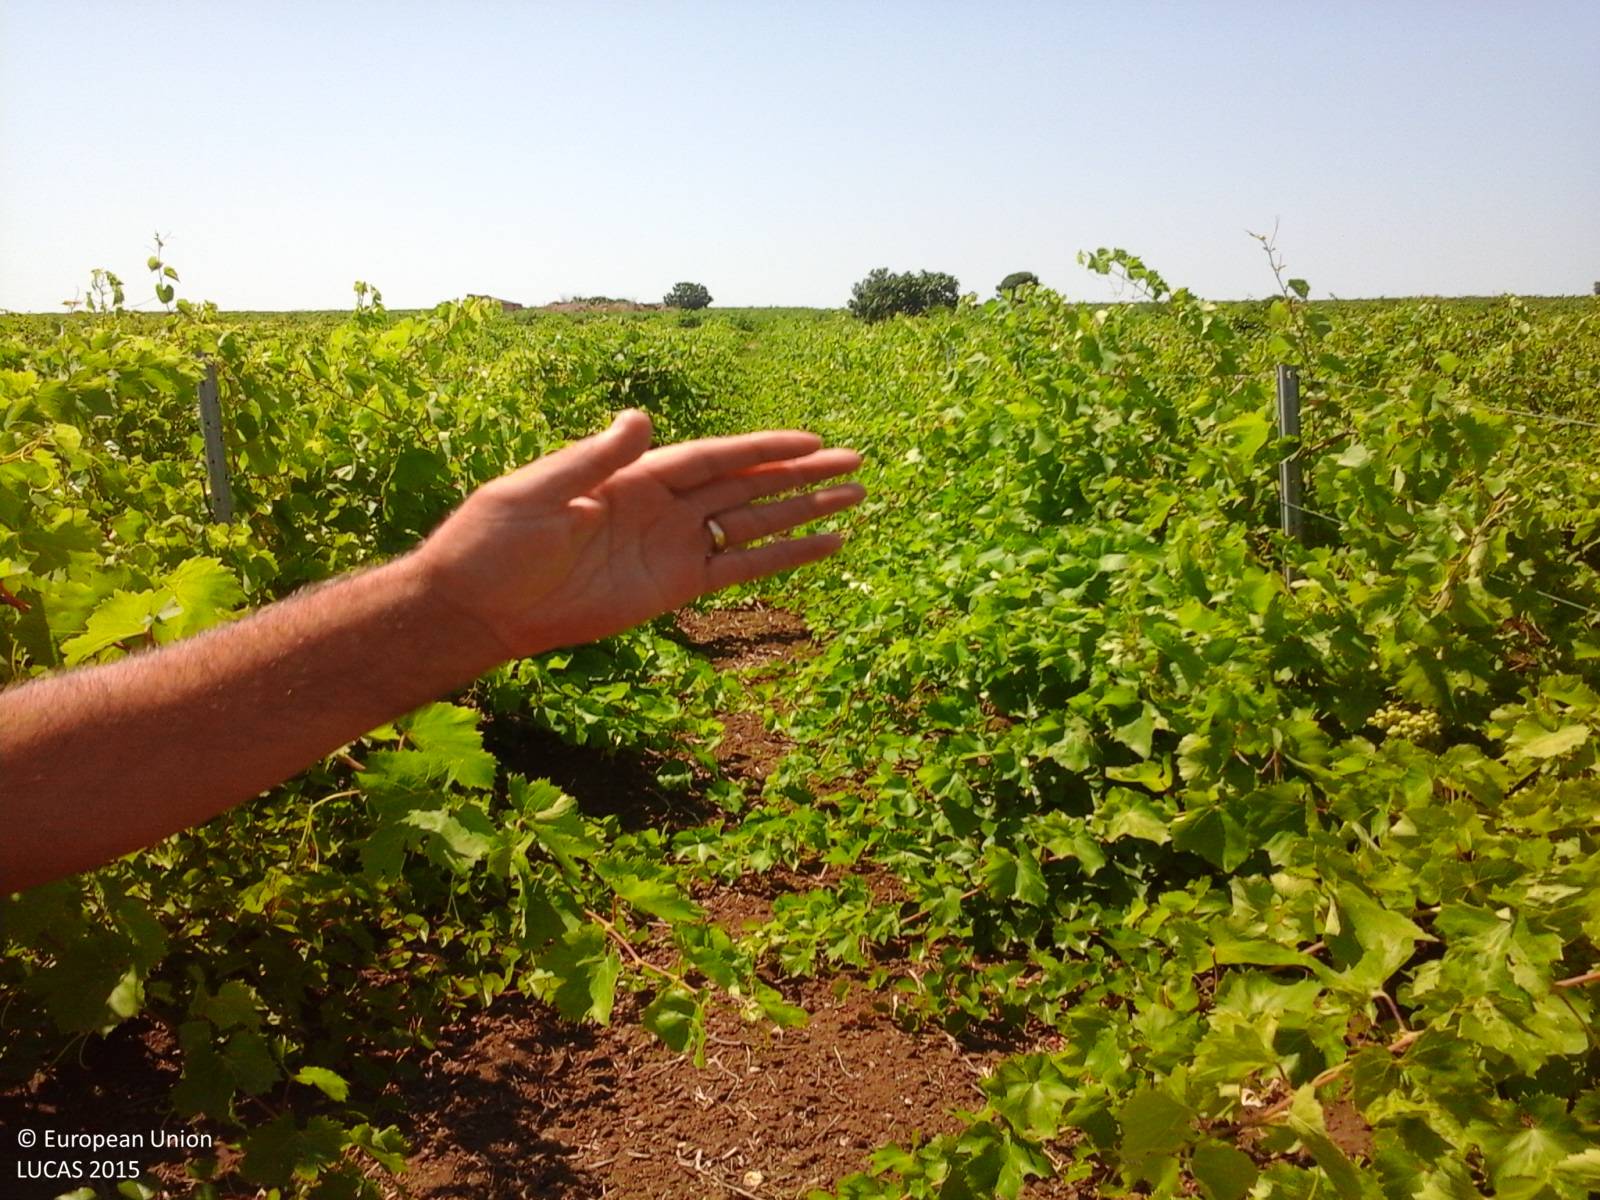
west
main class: Cropland
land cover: Vineyards
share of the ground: 50 - 75 %
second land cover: Other bare soil
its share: > 75 %
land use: Agriculture (excluding fallow land and kitchen gardens)
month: July
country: IT
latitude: 37.7289
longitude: 12.6464
